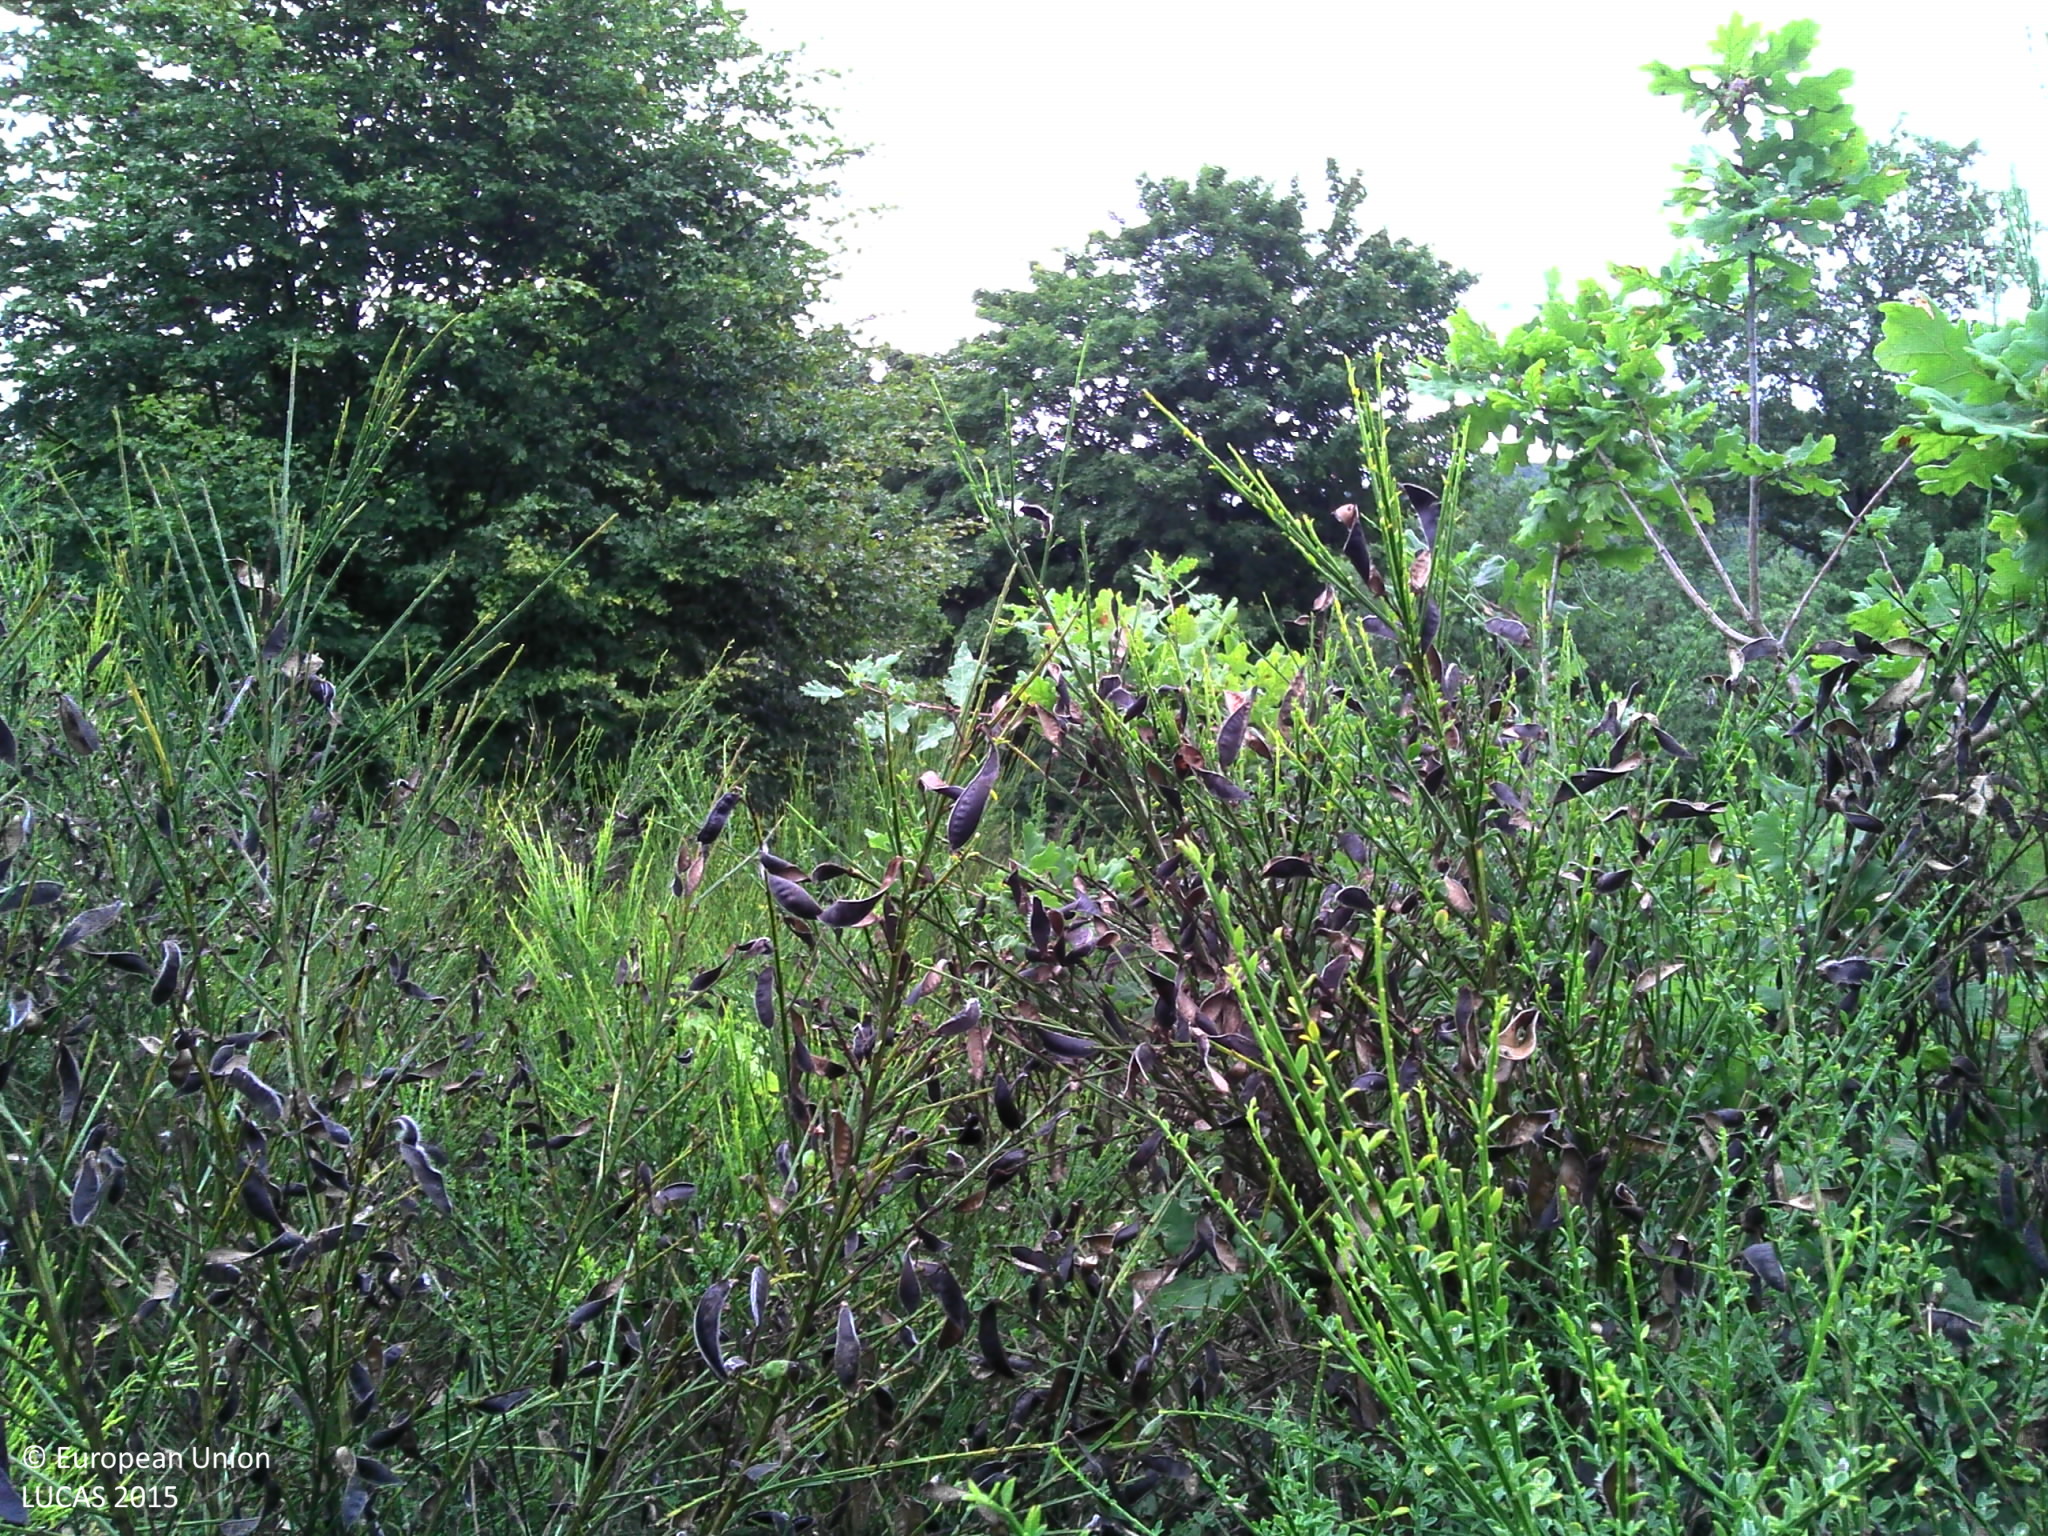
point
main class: Shrubland
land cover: Shrubland without tree cover
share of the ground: > 75 %
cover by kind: shrubs 90 %, herbaceous plants 10 %
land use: Semi-natural and natural areas not in use
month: August
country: FR
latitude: 45.4983
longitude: 1.8694
